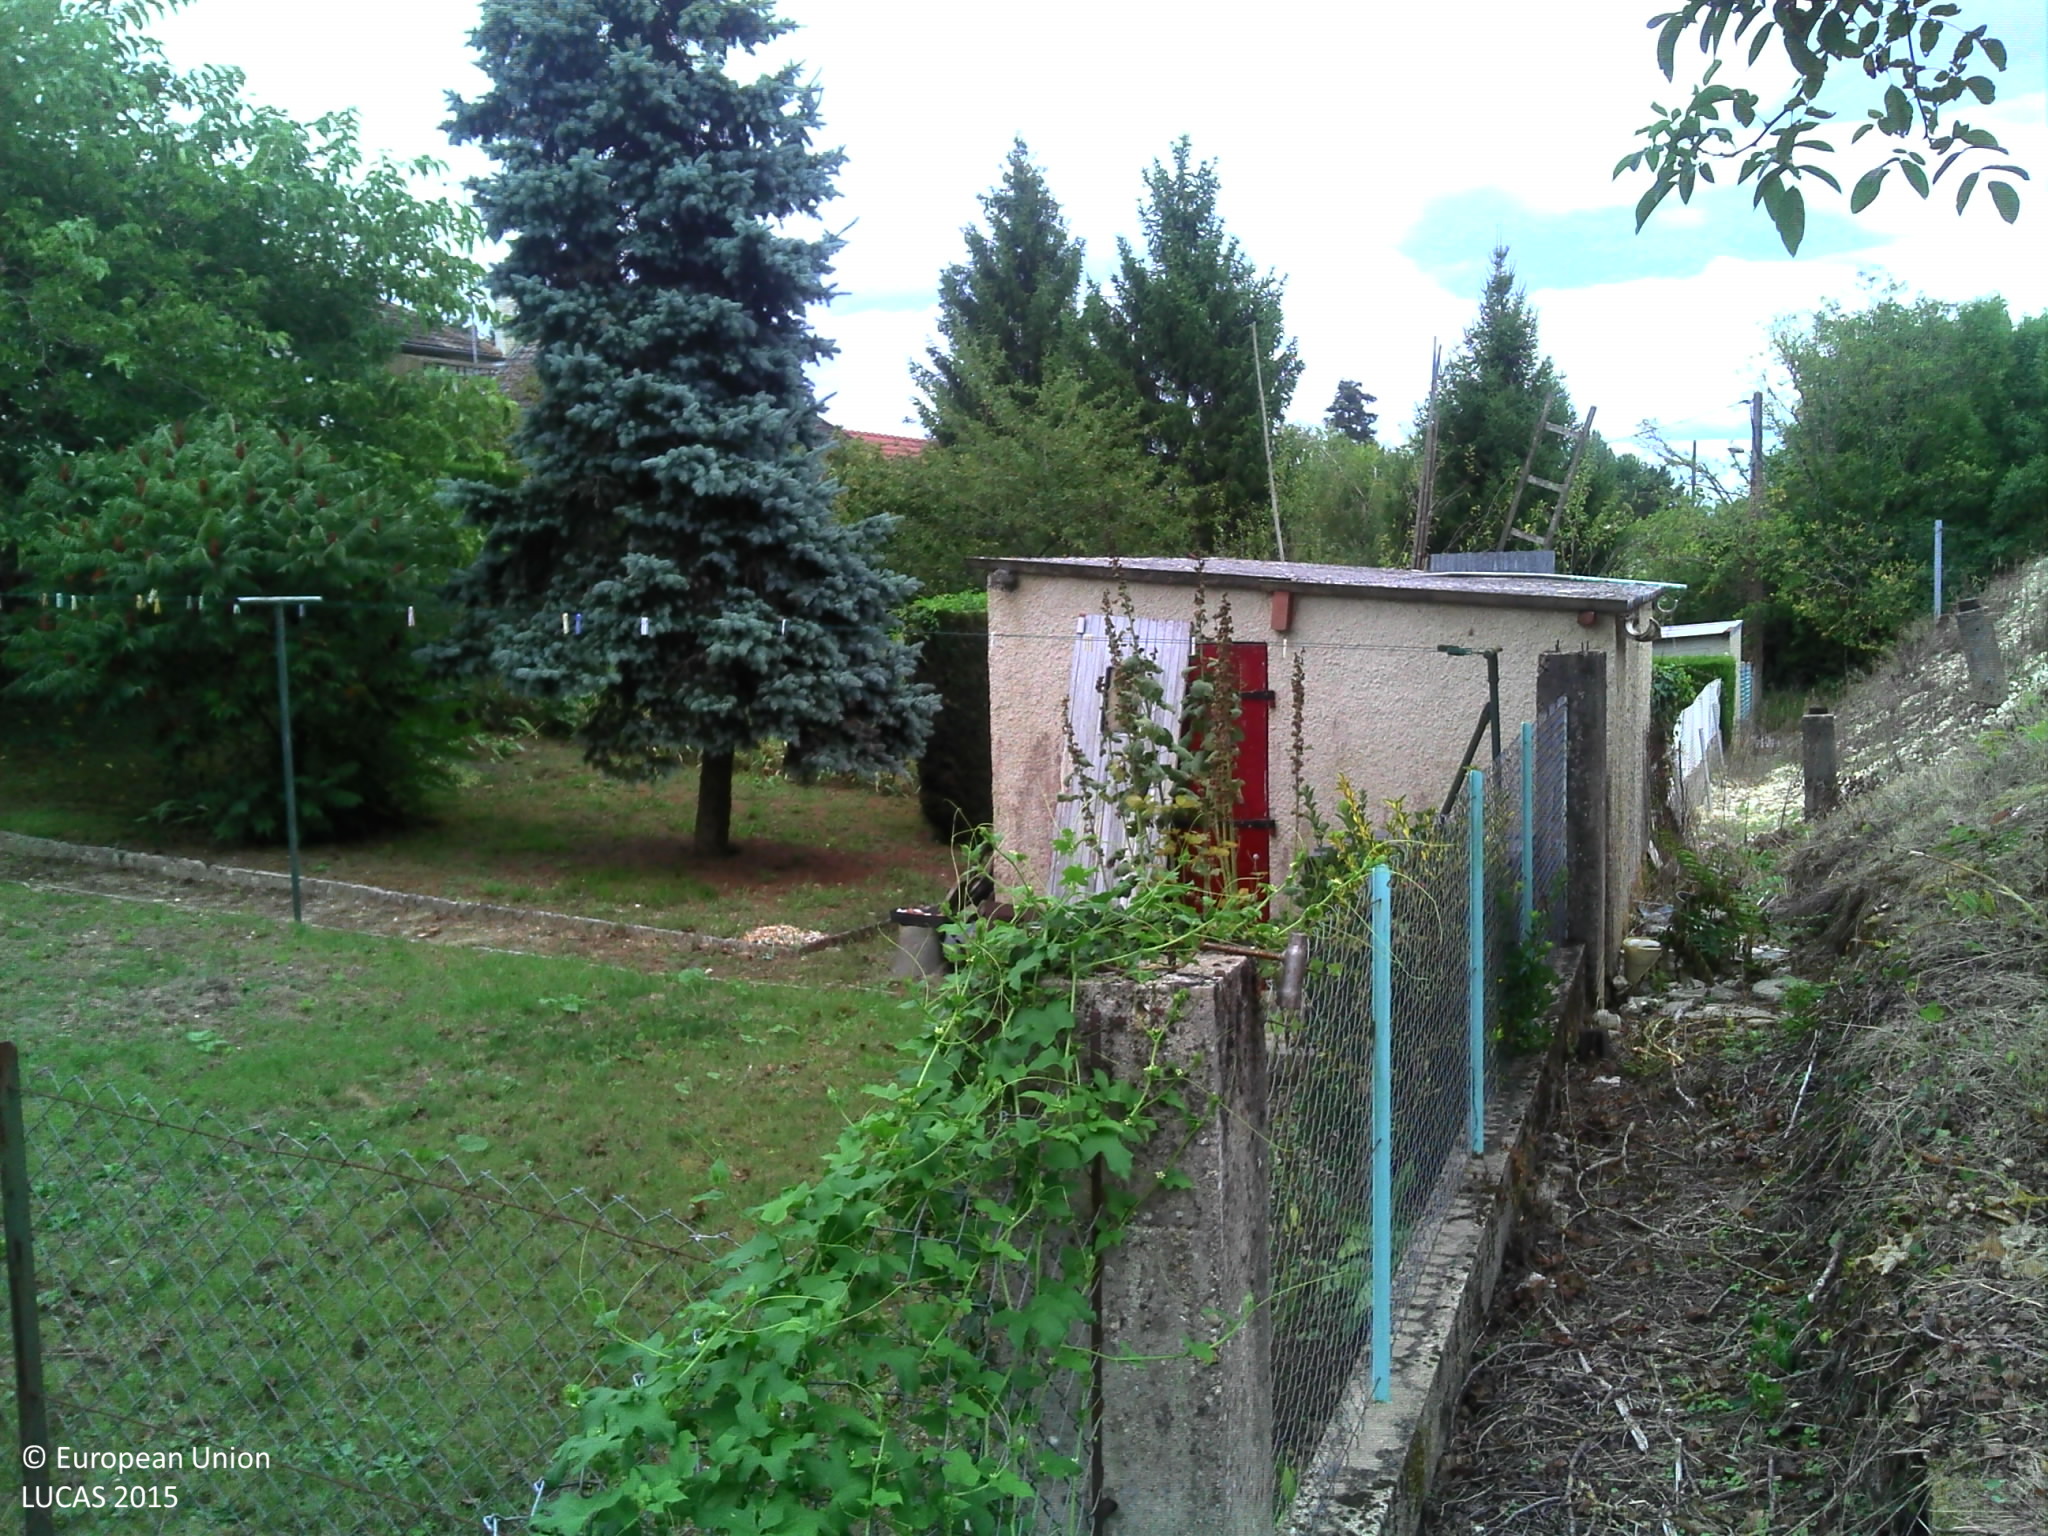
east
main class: Grassland
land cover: Grassland with sparse tree/shrub cover
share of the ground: > 75 %
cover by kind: herbaceous plants 55 %, unconsolidated bare surface 40 %, broadleaved forest trees 5 %
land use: Residential
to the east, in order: Grassland with sparse tree/shrub cover; Artificial constructions in urban areas
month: September
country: FR
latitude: 46.8476
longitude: 1.5301
